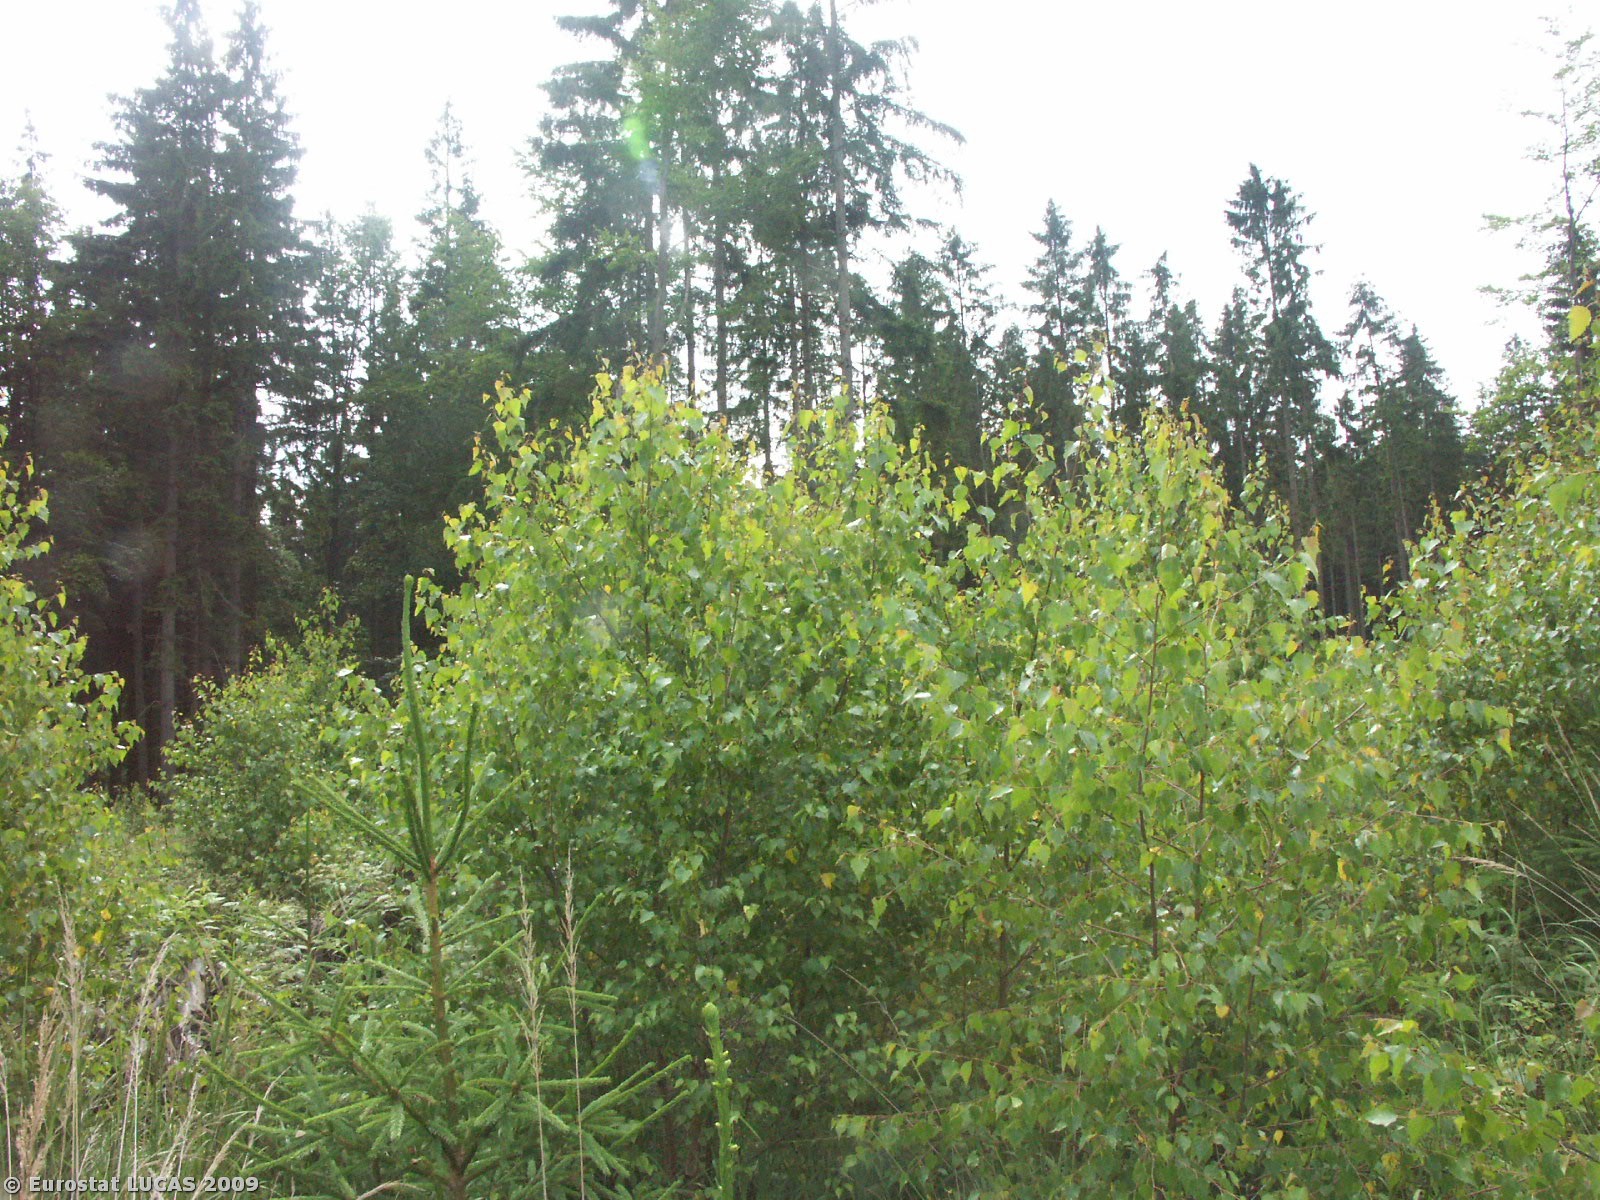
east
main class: Woodland
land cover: Mixed woodland
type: hemiboreal forest and nemoral coniferous forest and mixed broadleaved-coniferous forest
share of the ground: > 75 %
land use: Forestry
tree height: > 5 m
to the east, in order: Mixed woodland; Ditches and canals; Tracks; Mixed woodland; Broadleaved woodland; Rivers and streams; Broadleaved woodland; Ditches and canals; Fences; Broadleaved woodland; Fences; Coniferous woodland
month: July
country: CZ
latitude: 49.9035
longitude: 17.4610
